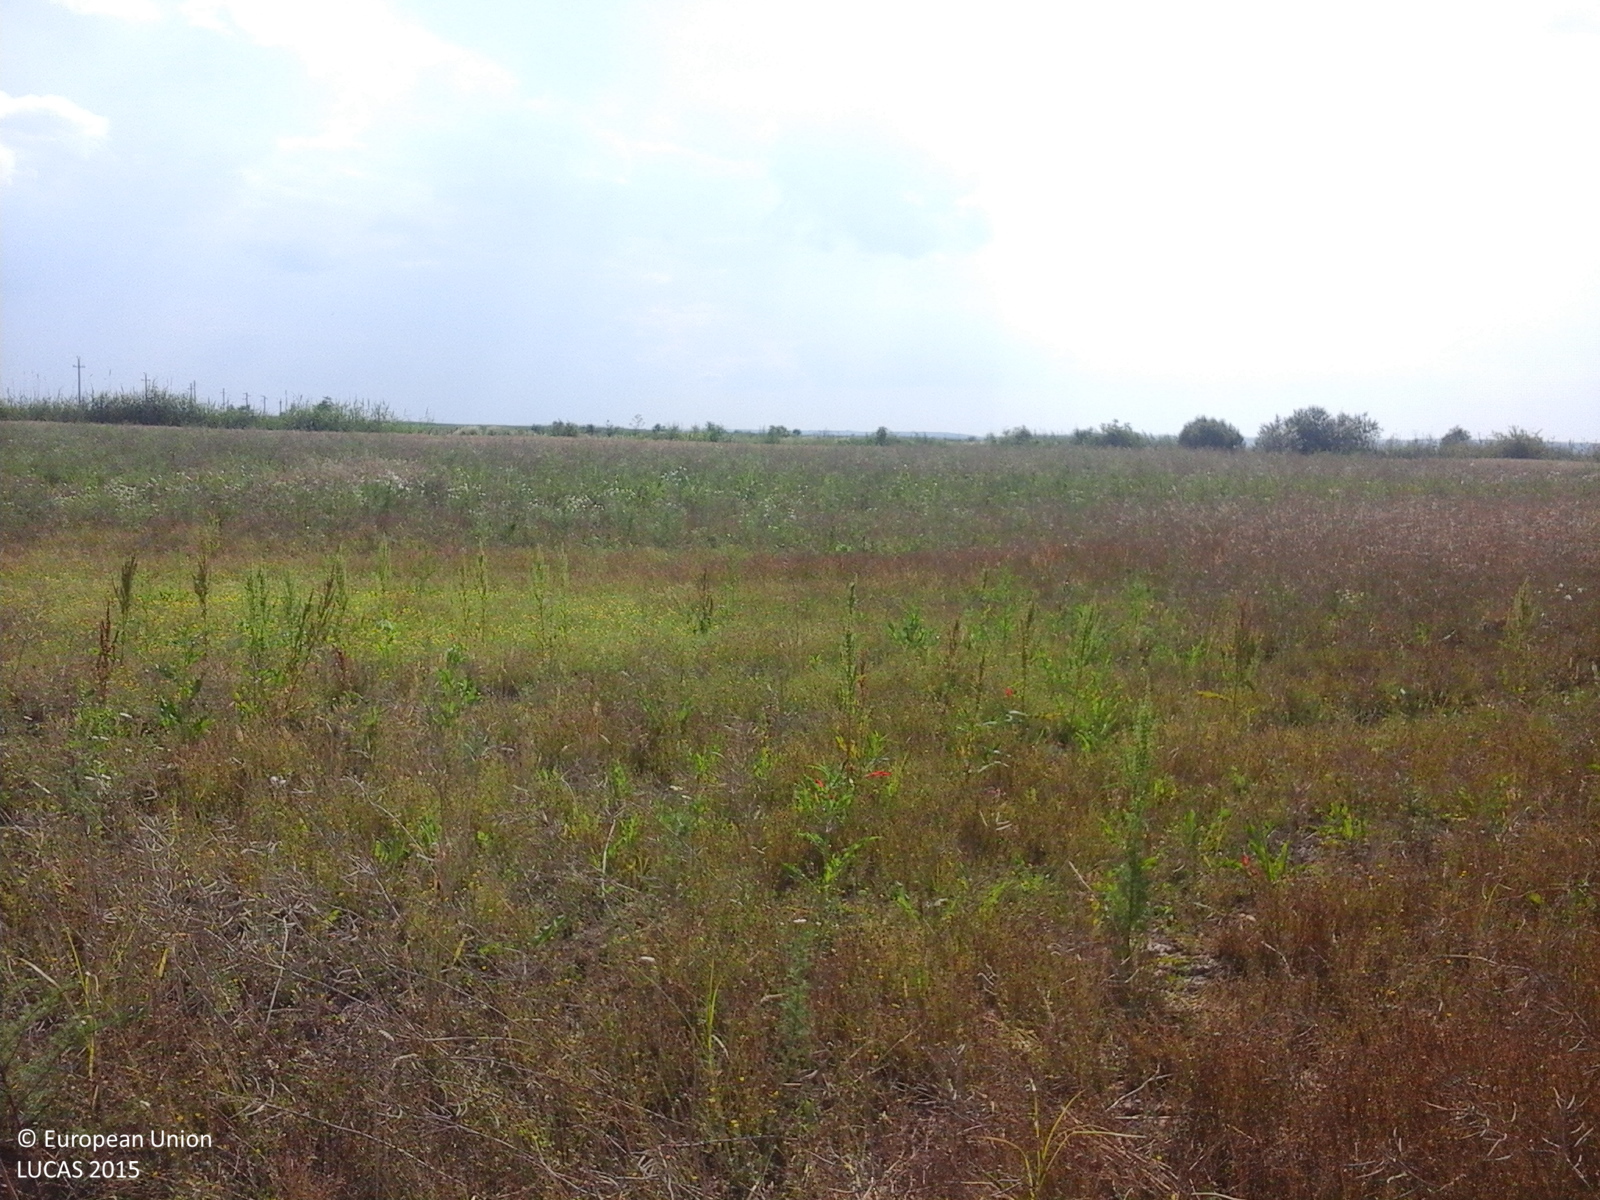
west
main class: Grassland
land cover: Spontaneously vegetated surfaces
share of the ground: > 75 %
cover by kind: herbaceous plants 100 %
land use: Fallow land
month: July
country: RO
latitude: 44.0014
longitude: 26.1011
